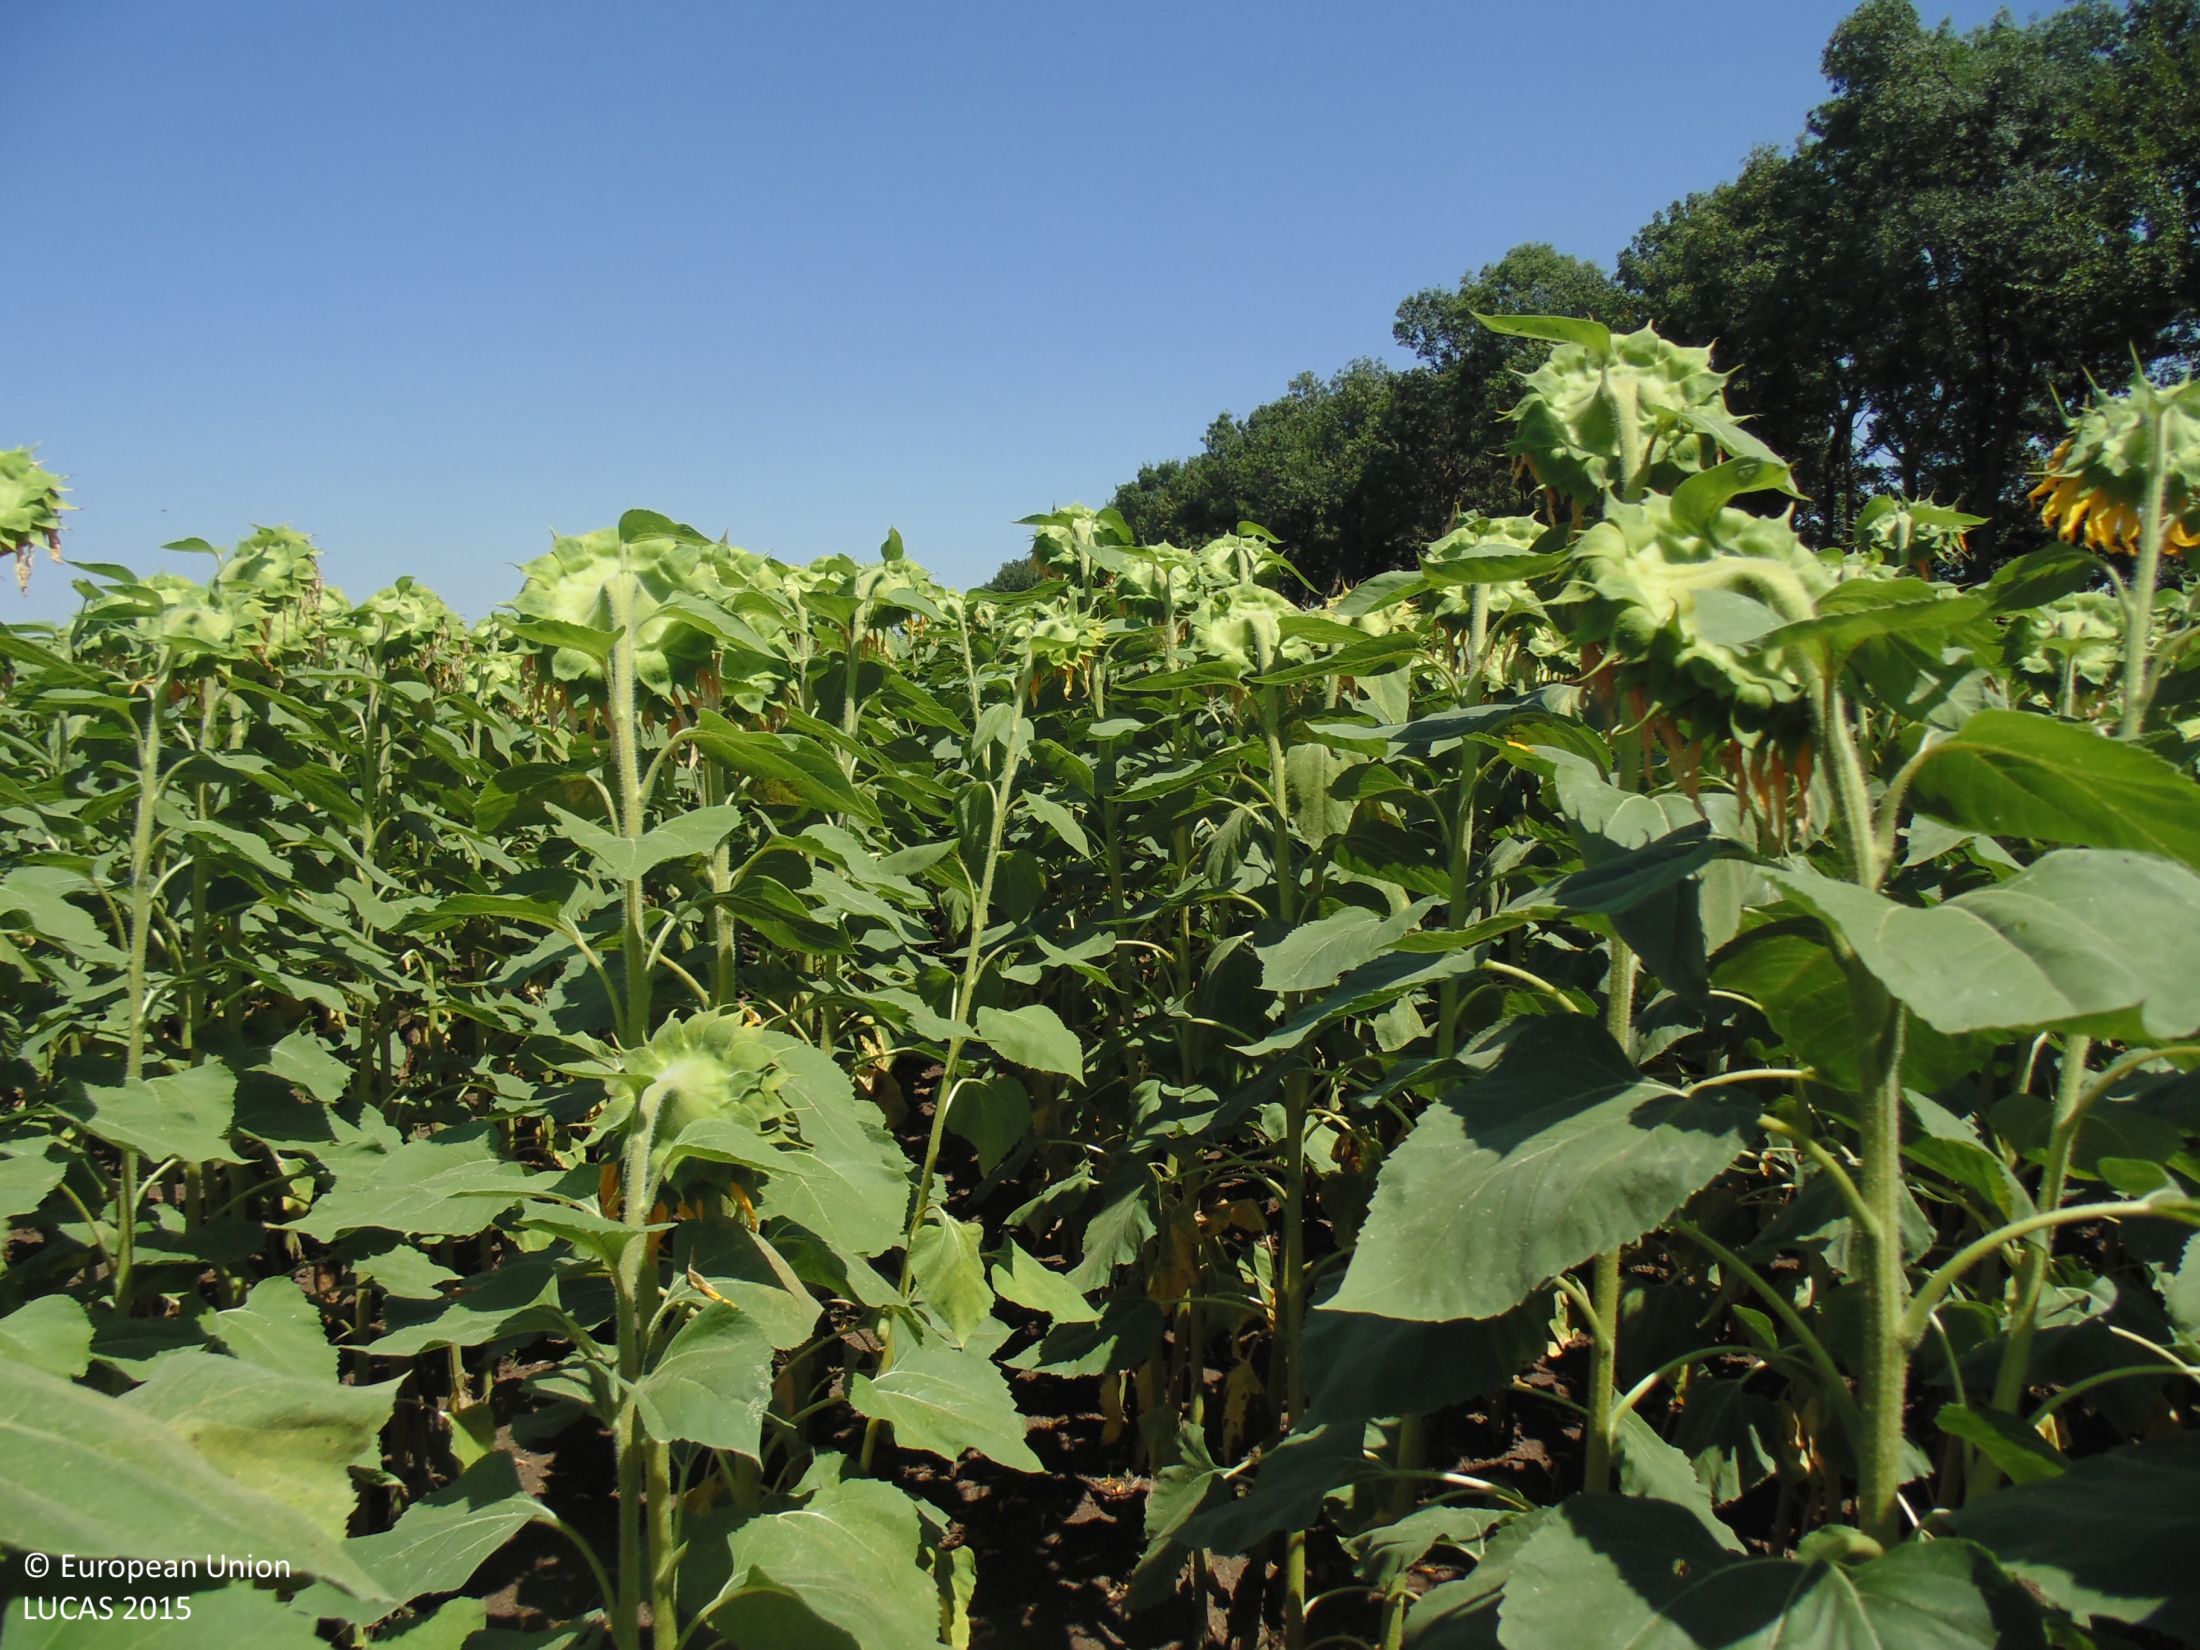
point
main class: Cropland
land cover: Sunflower
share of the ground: > 75 %
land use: Agriculture (excluding fallow land and kitchen gardens)
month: July
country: BG
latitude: 43.4914
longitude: 28.1419
